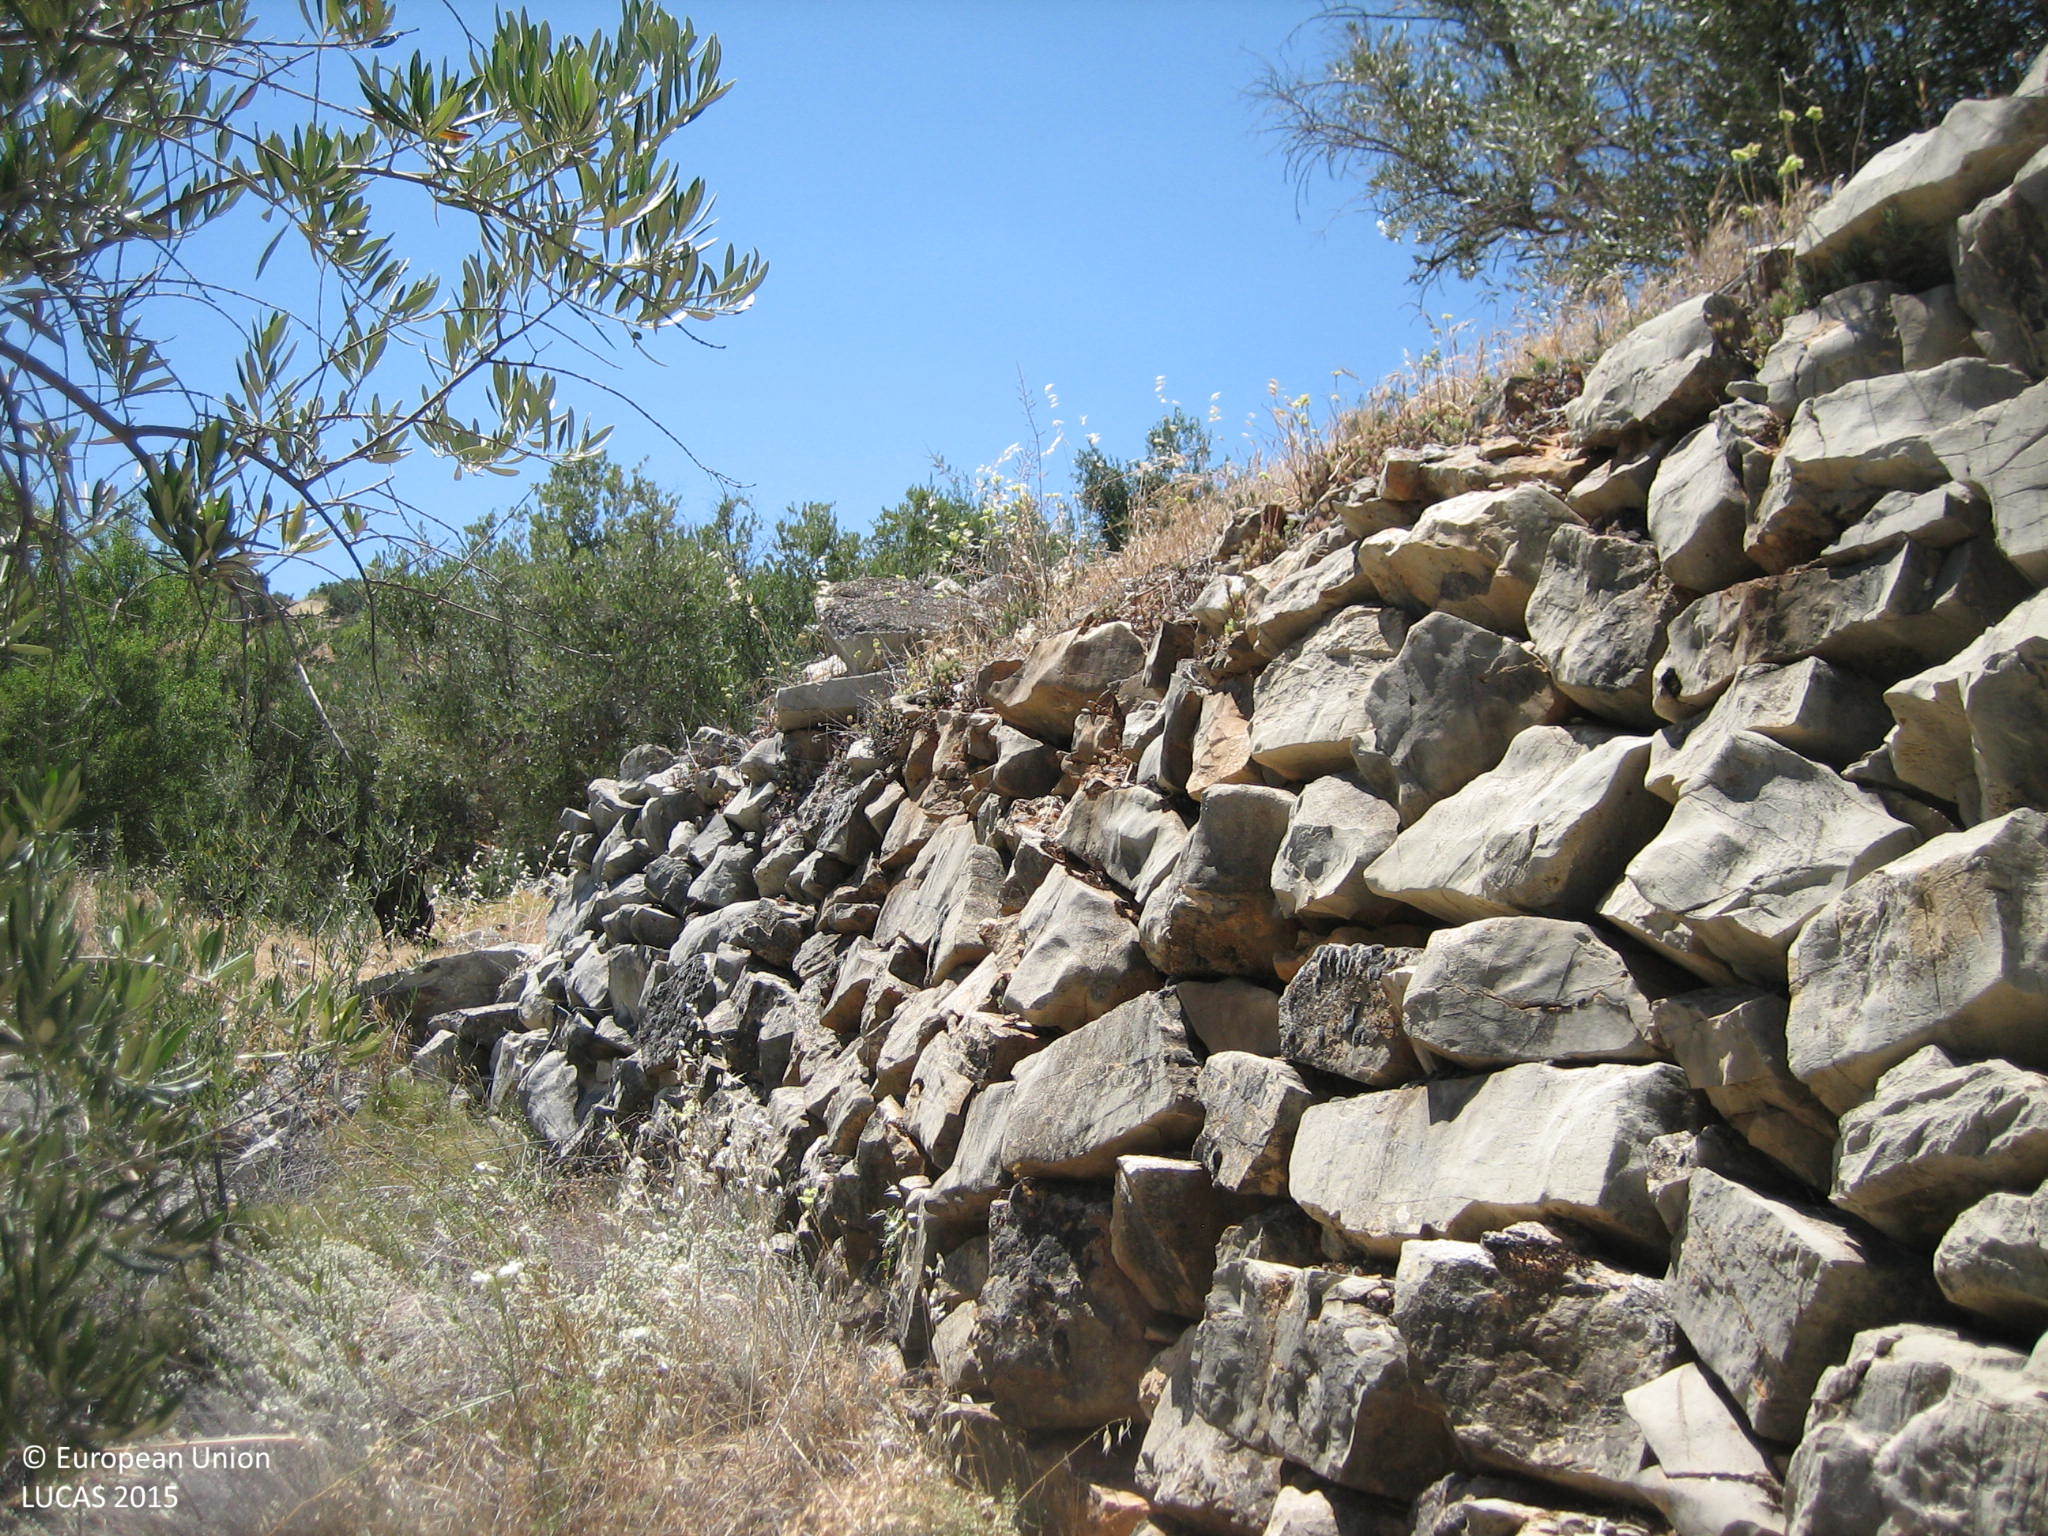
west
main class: Cropland
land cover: Olive groves
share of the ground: 10 - 25 %
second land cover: Spontaneously vegetated surfaces
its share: 10 - 25 %
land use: Agriculture (excluding fallow land and kitchen gardens)
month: June
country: ES
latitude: 37.7088
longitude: -3.8045
